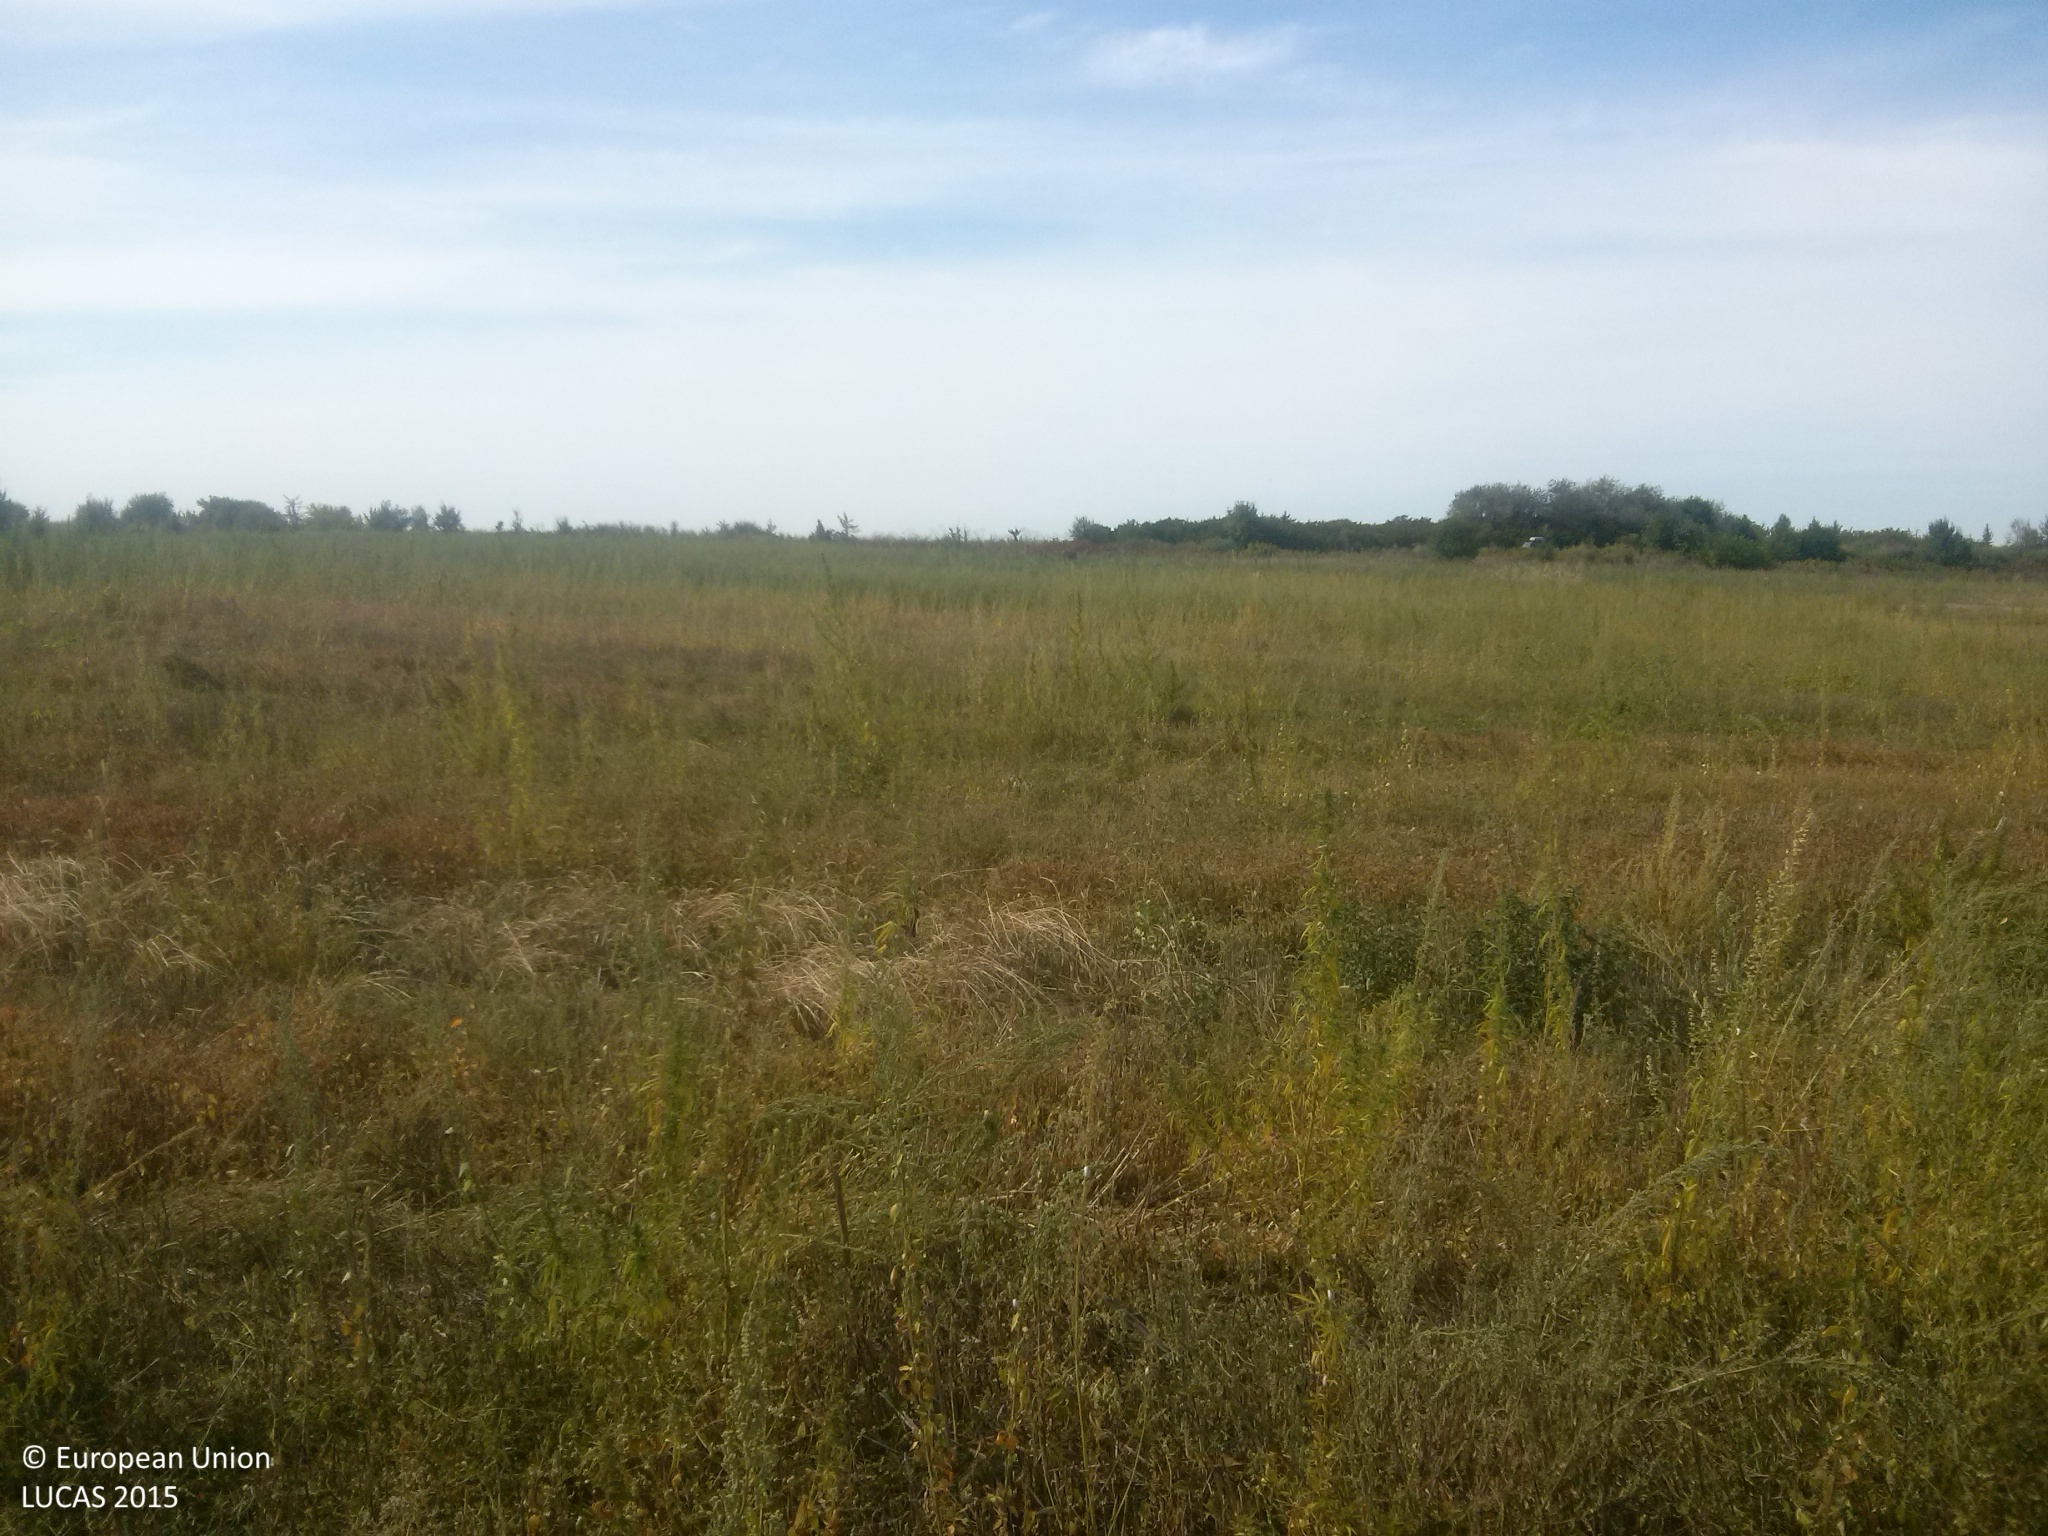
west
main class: Cropland
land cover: Common wheat
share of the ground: 25 - 50 %
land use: Agriculture (excluding fallow land and kitchen gardens)
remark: Harvested field
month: September
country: BG
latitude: 43.6855
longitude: 26.2400
